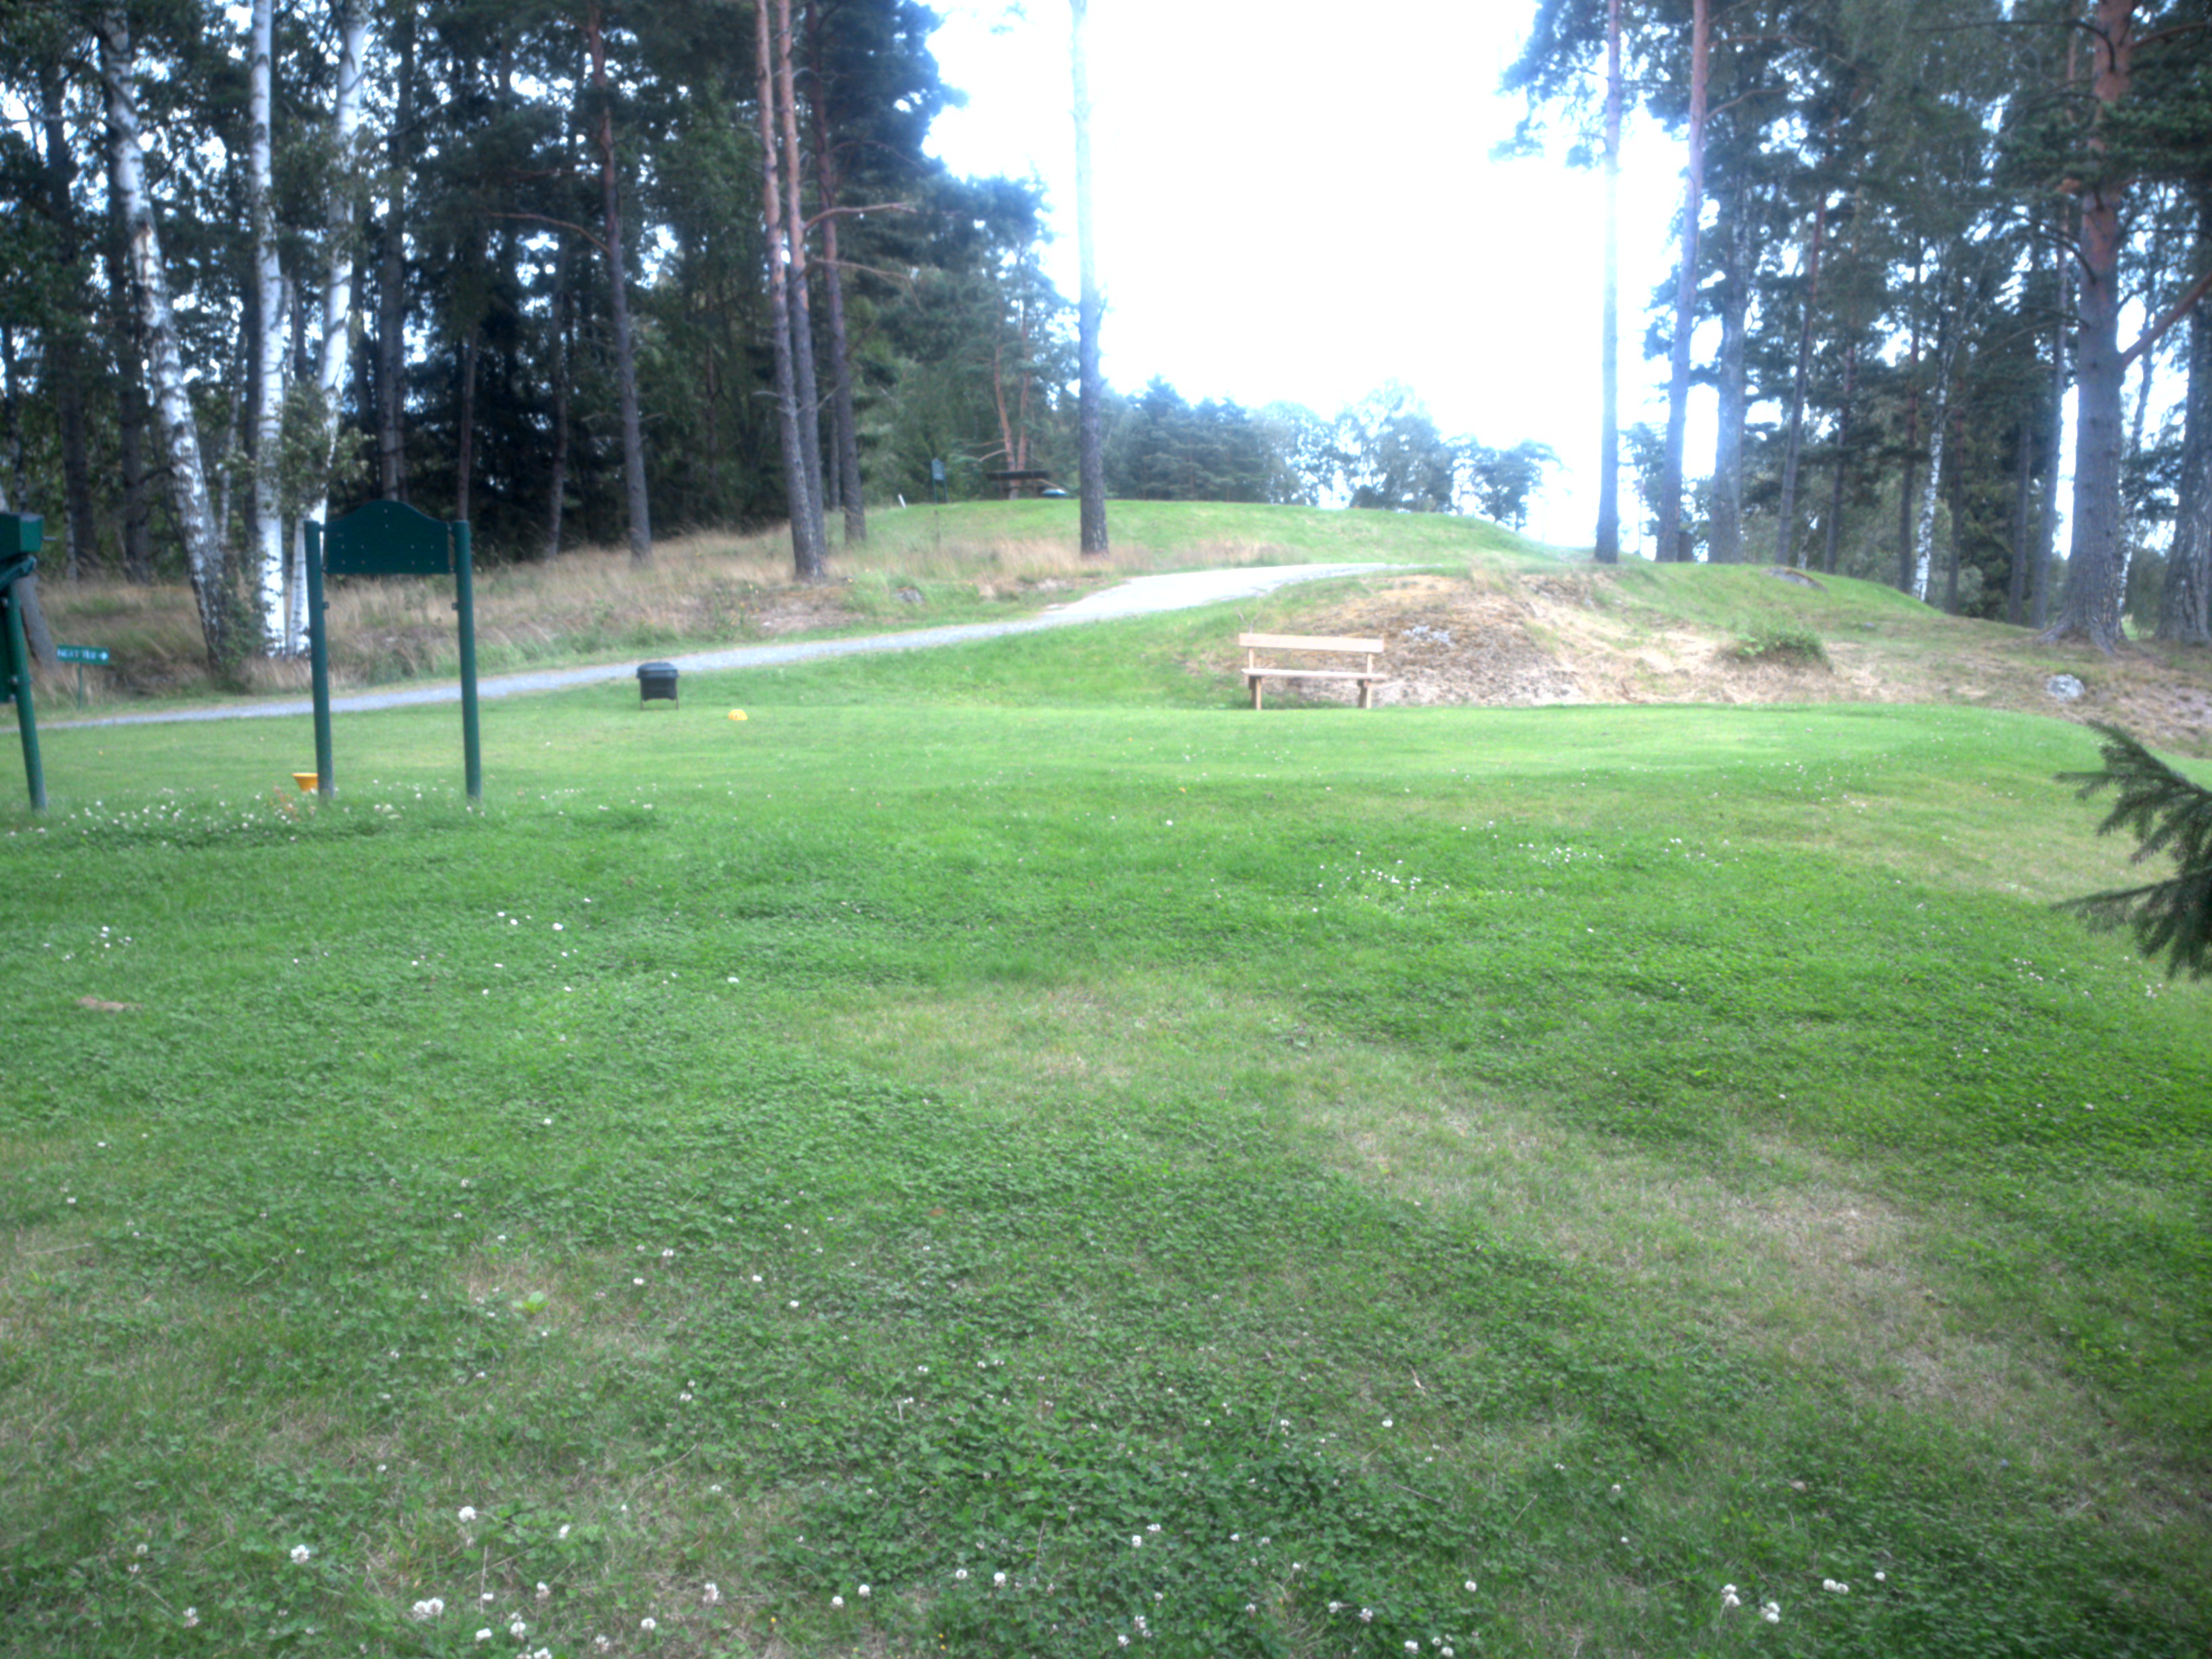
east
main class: Grassland
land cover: Grassland with sparse tree/shrub cover
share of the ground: > 75 %
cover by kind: herbaceous plants 95 %, broadleaved forest trees 5 %
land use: Sport
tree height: > 5 m
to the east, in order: Grassland with sparse tree/shrub cover; Tracks; Grassland with sparse tree/shrub cover; Tracks; Grassland with sparse tree/shrub cover; Ditches and canals; Grassland with sparse tree/shrub cover; Tracks; Grassland with sparse tree/shrub cover; Tracks; Grassland with sparse tree/shrub cover
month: July
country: SE
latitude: 59.2523
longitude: 18.2242
